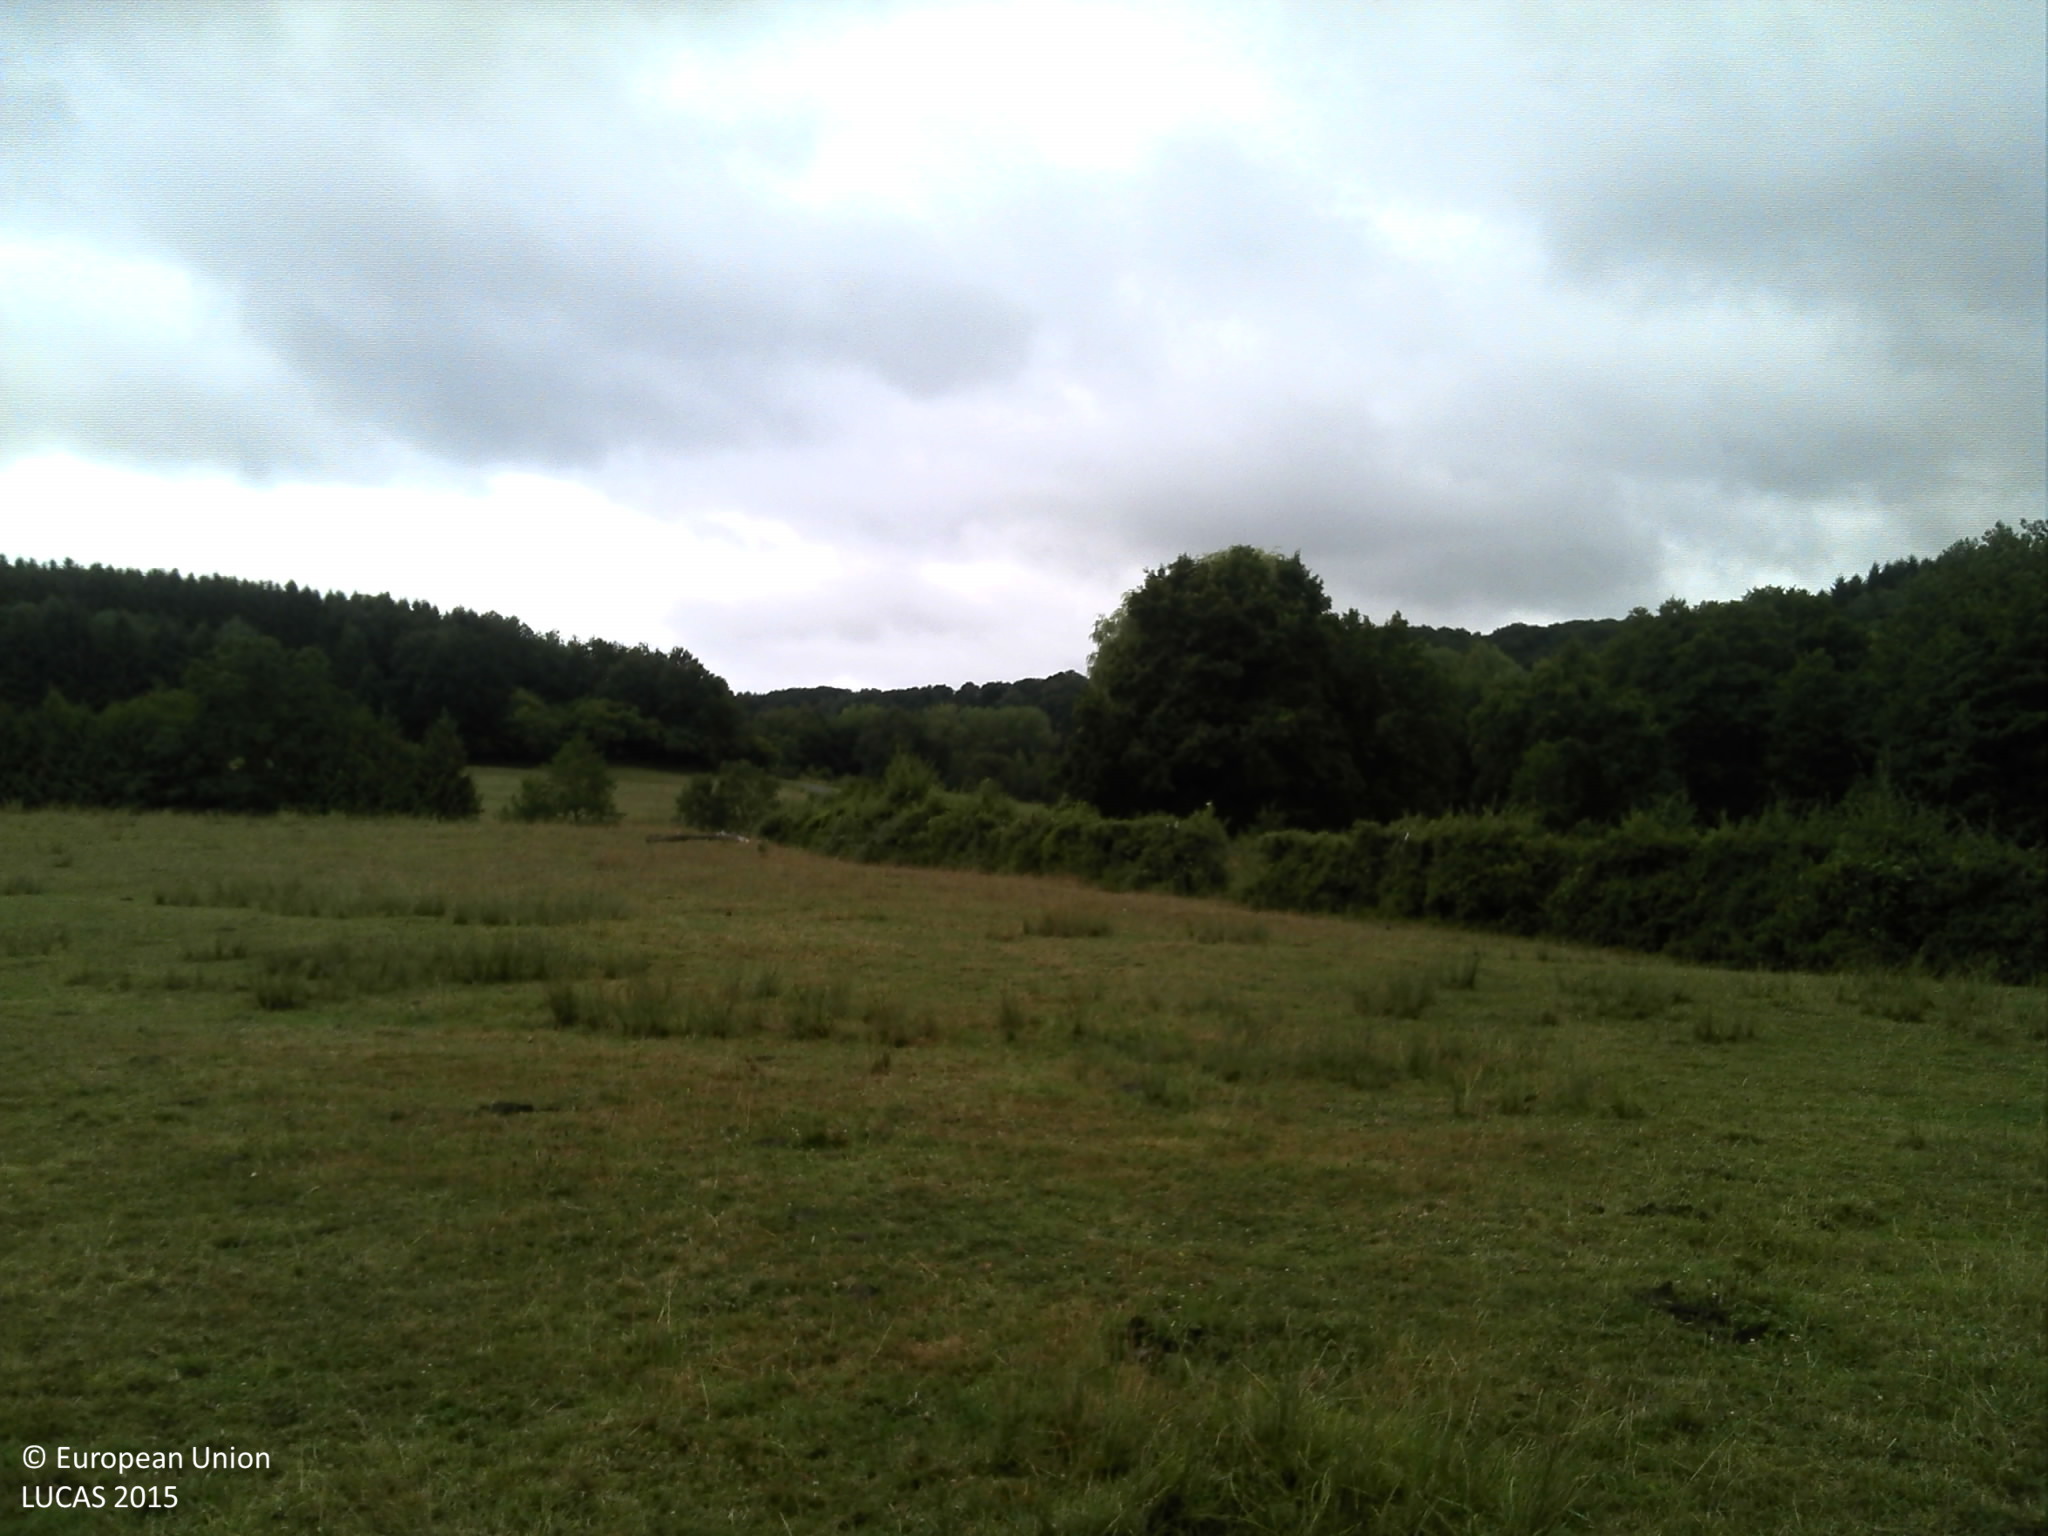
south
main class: Grassland
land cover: Grassland without tree/shrub cover
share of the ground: > 75 %
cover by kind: herbaceous plants 100 %
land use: Agriculture (excluding fallow land and kitchen gardens)
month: July
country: FR
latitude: 49.4335
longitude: 4.7709
